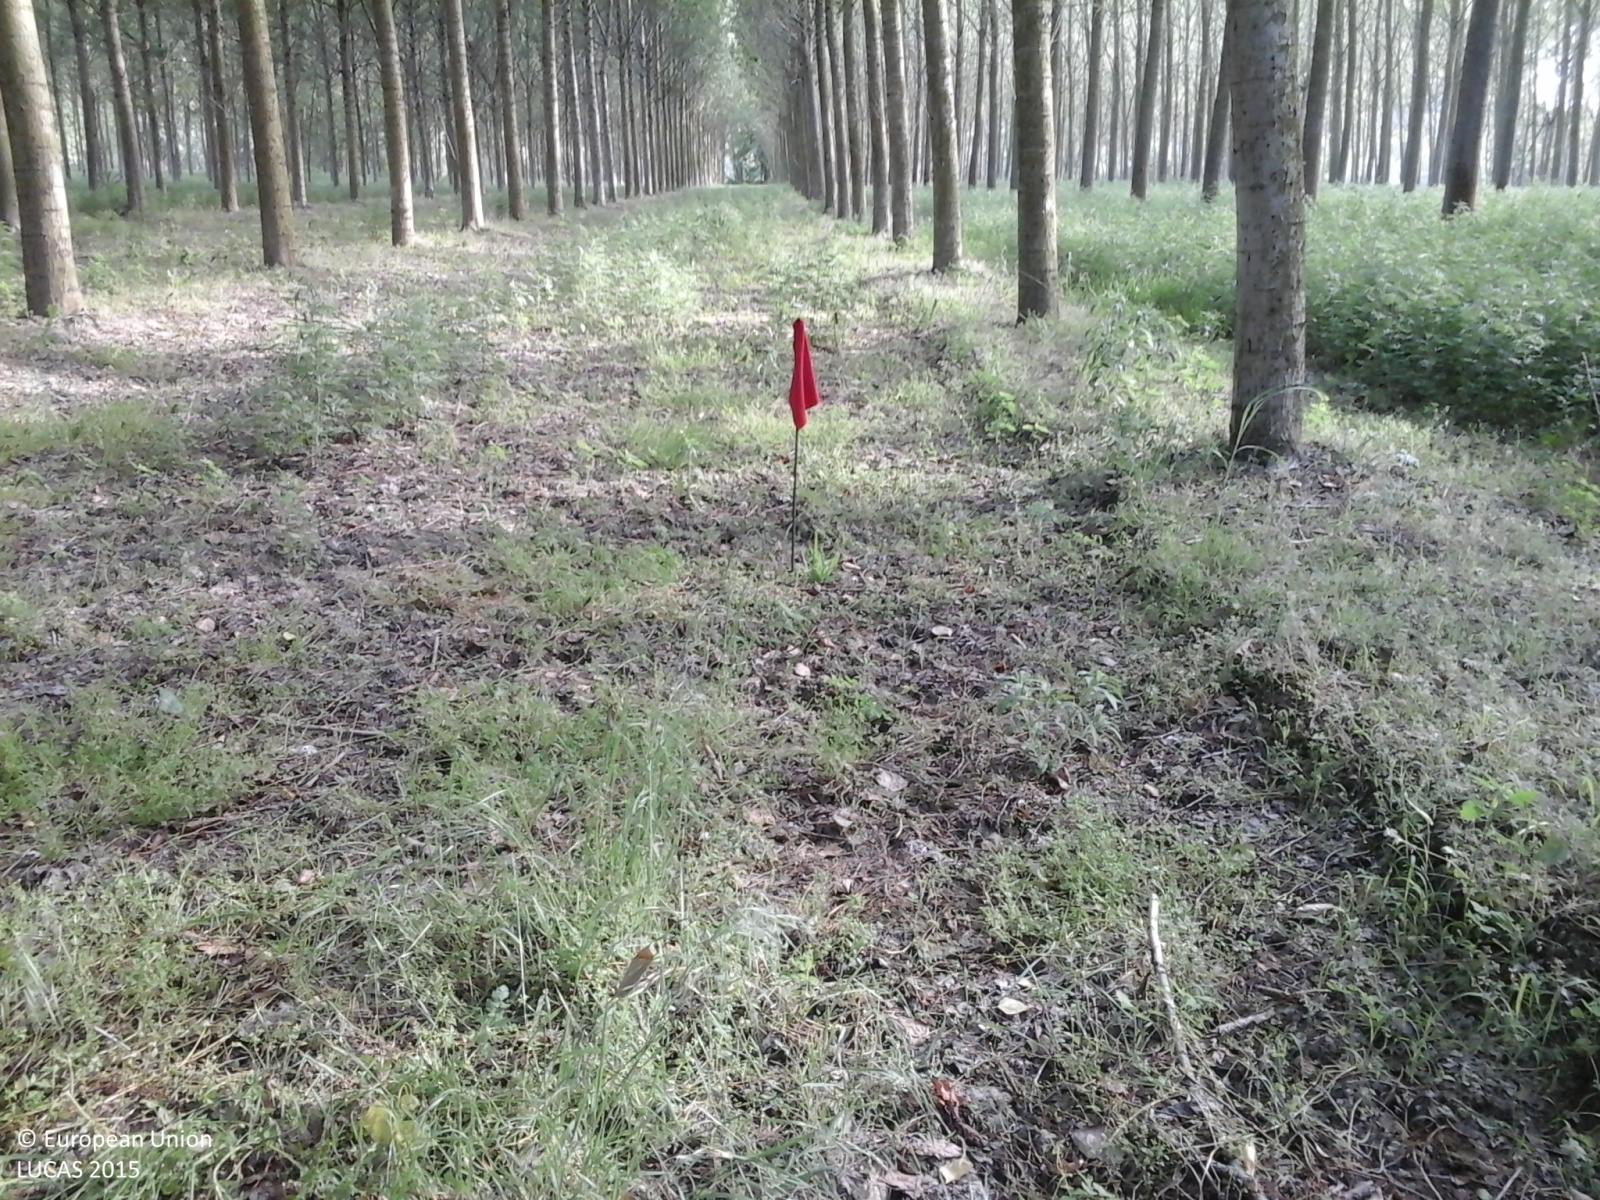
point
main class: Woodland
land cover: Broadleaved woodland
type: non-riverine alder, birch or aspen forest
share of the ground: > 75 %
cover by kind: broadleaved forest trees 80 %, herbaceous plants 20 %
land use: Forestry
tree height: > 5 m
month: May
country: IT
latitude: 45.1810
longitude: 8.1072
